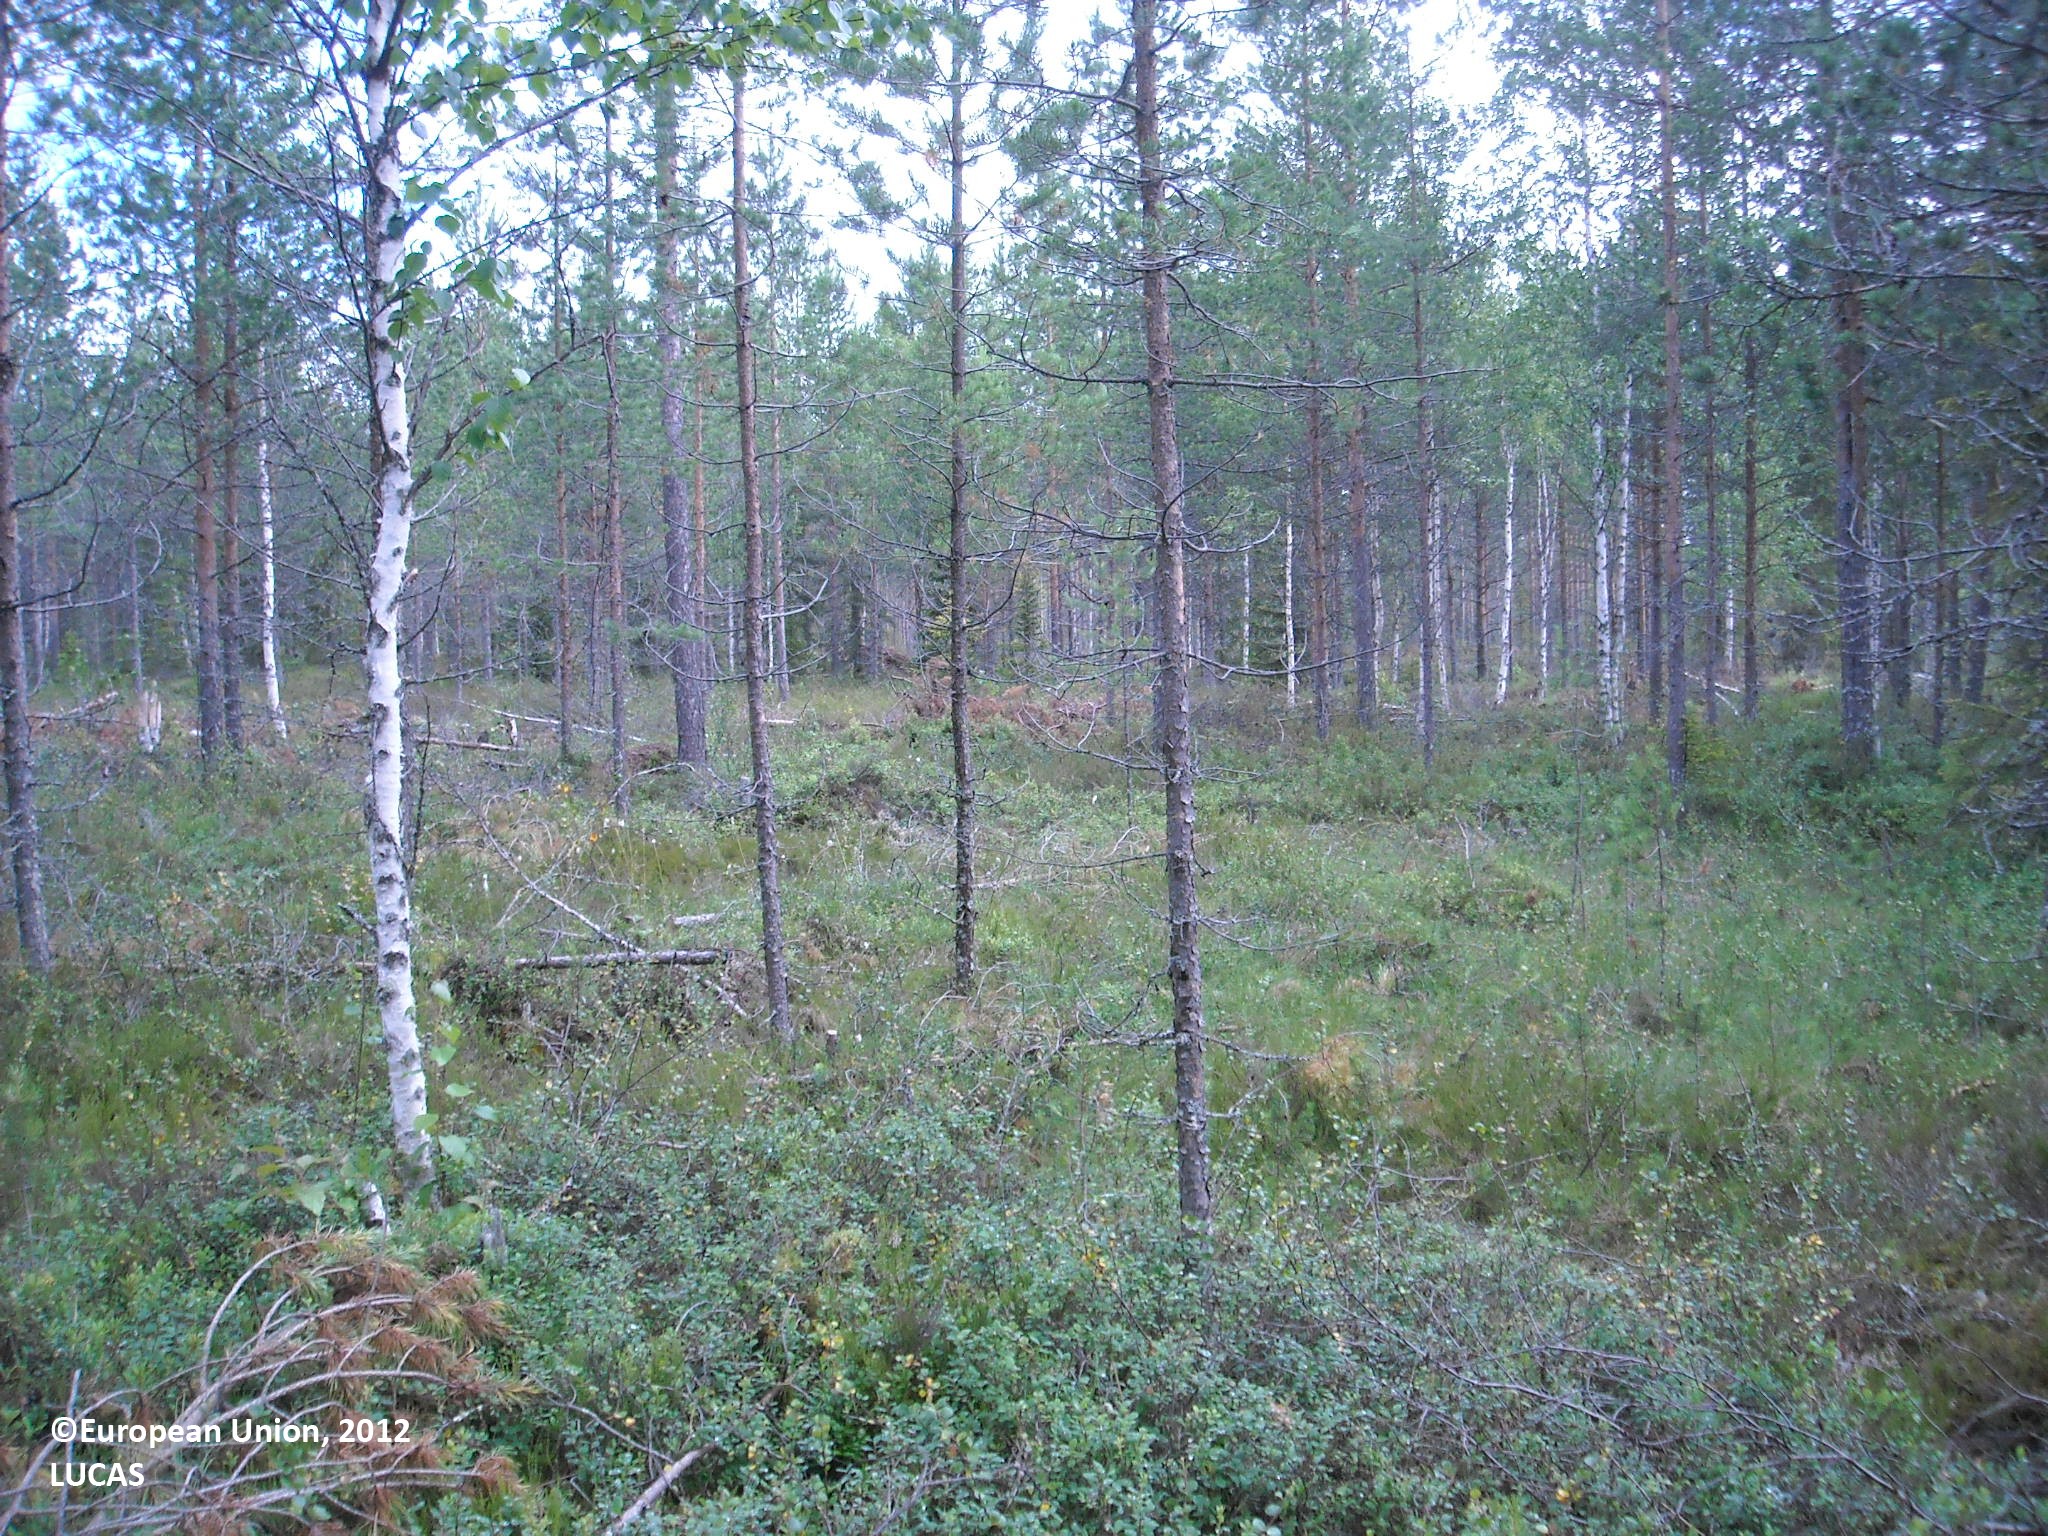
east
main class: Woodland
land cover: Pine dominated mixed woodland
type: mire and swamp forests
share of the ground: 50 - 75 %
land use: Forestry
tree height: > 5 m
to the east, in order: Pine dominated mixed woodland; Ditches and canals; Pine dominated mixed woodland; Pine dominated coniferous woodland; Ditches and canals; Grass margins; Paved roads, cycling and walking lanes; Grass margins; Ditches and canals; Pine dominated coniferous woodland; Pine dominated mixed woodland
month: July
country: FI
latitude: 64.9646
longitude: 27.6127
